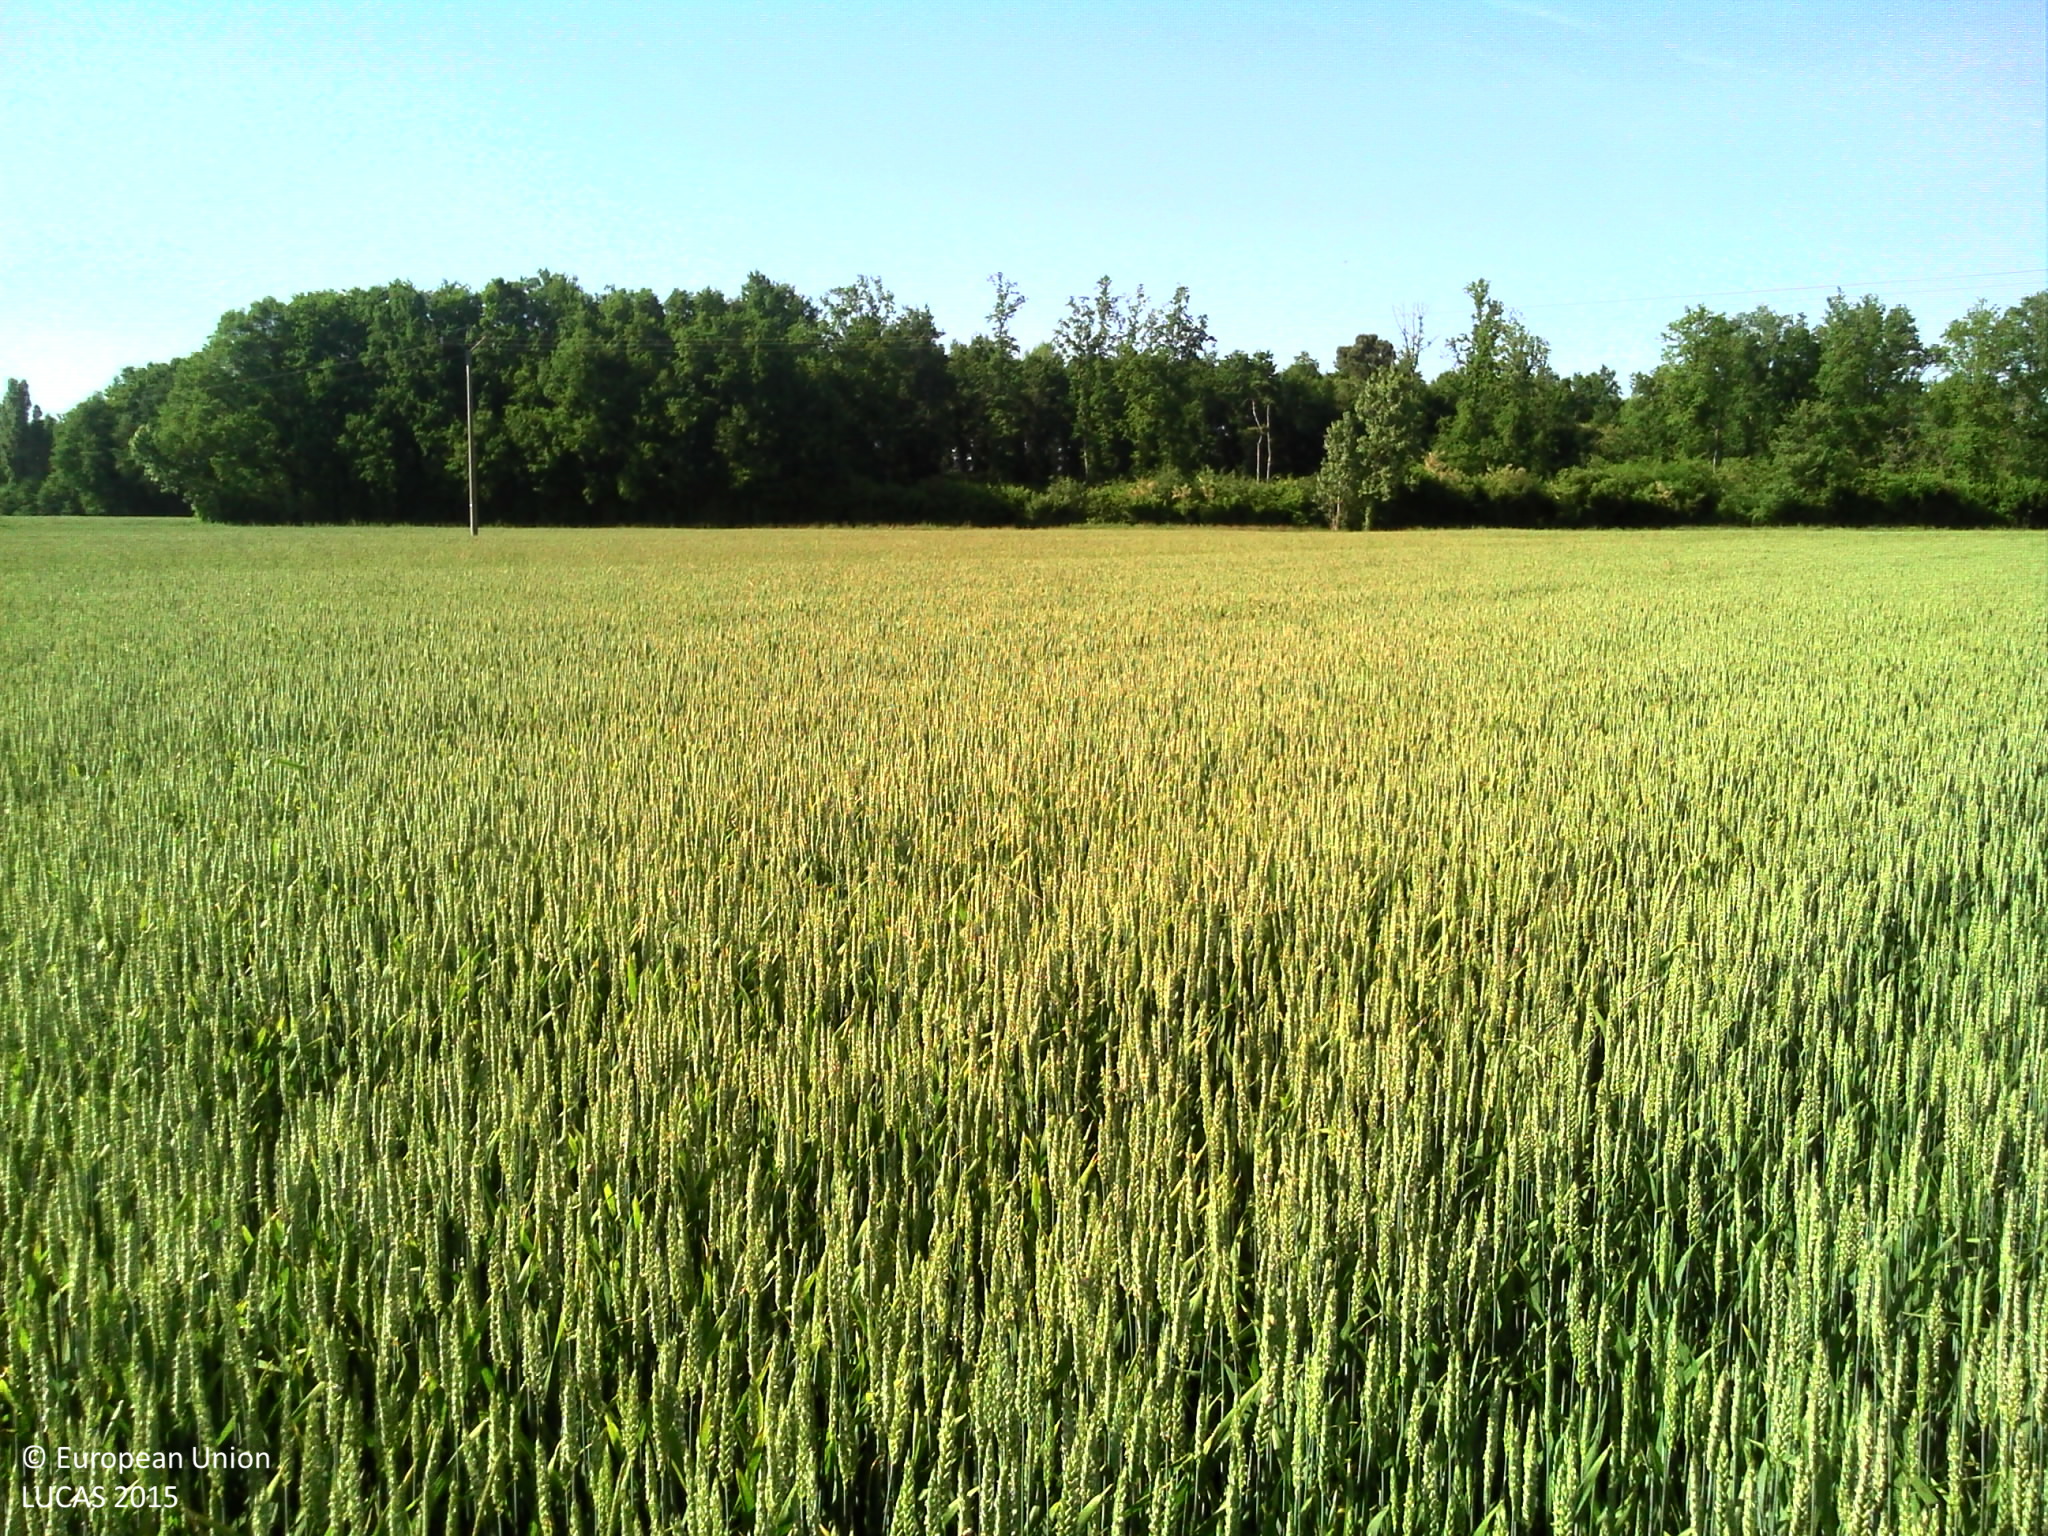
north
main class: Cropland
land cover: Common wheat
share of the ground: > 75 %
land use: Agriculture (excluding fallow land and kitchen gardens)
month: May
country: FR
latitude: 46.8239
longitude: 0.1867
